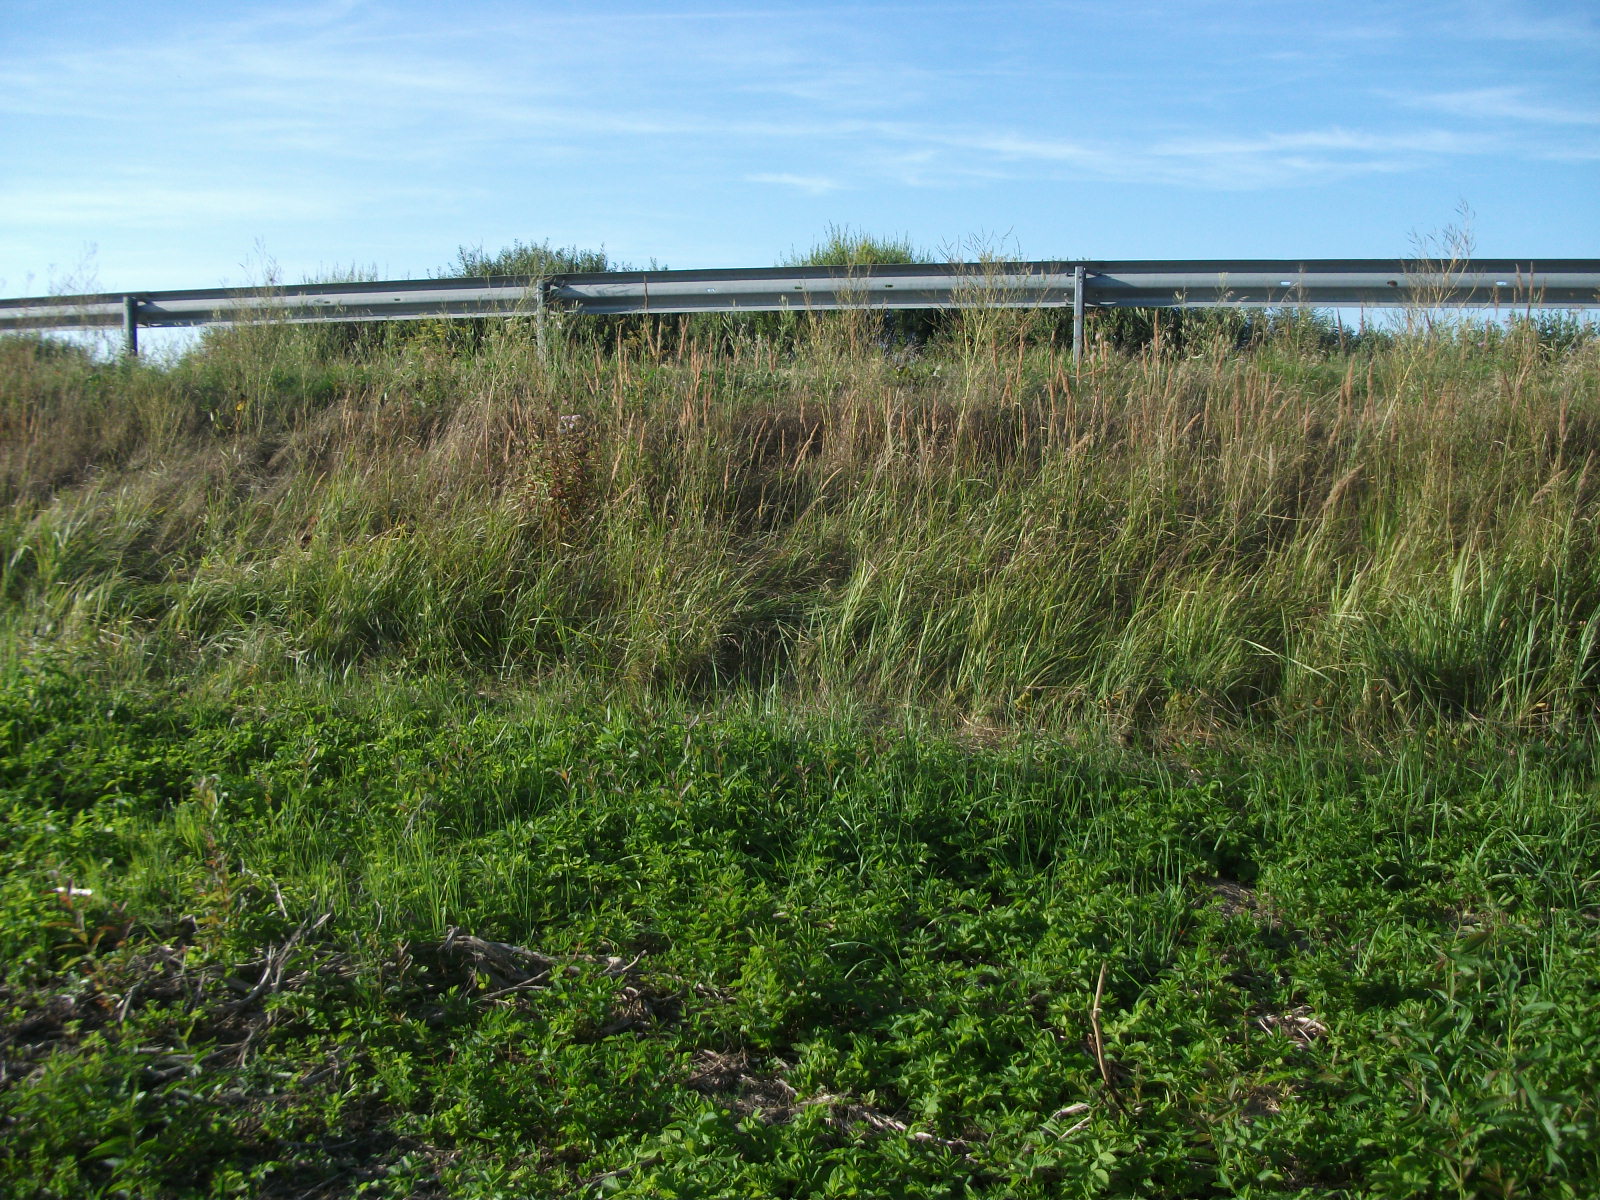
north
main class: Grassland
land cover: Spontaneously vegetated surfaces
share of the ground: 25 - 50 %
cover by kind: unconsolidated bare surface 50 %, herbaceous plants 45 %, shrubs 5 %
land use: Telecommunication
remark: Clear cut
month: August
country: LV
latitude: 56.5344
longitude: 26.2877
